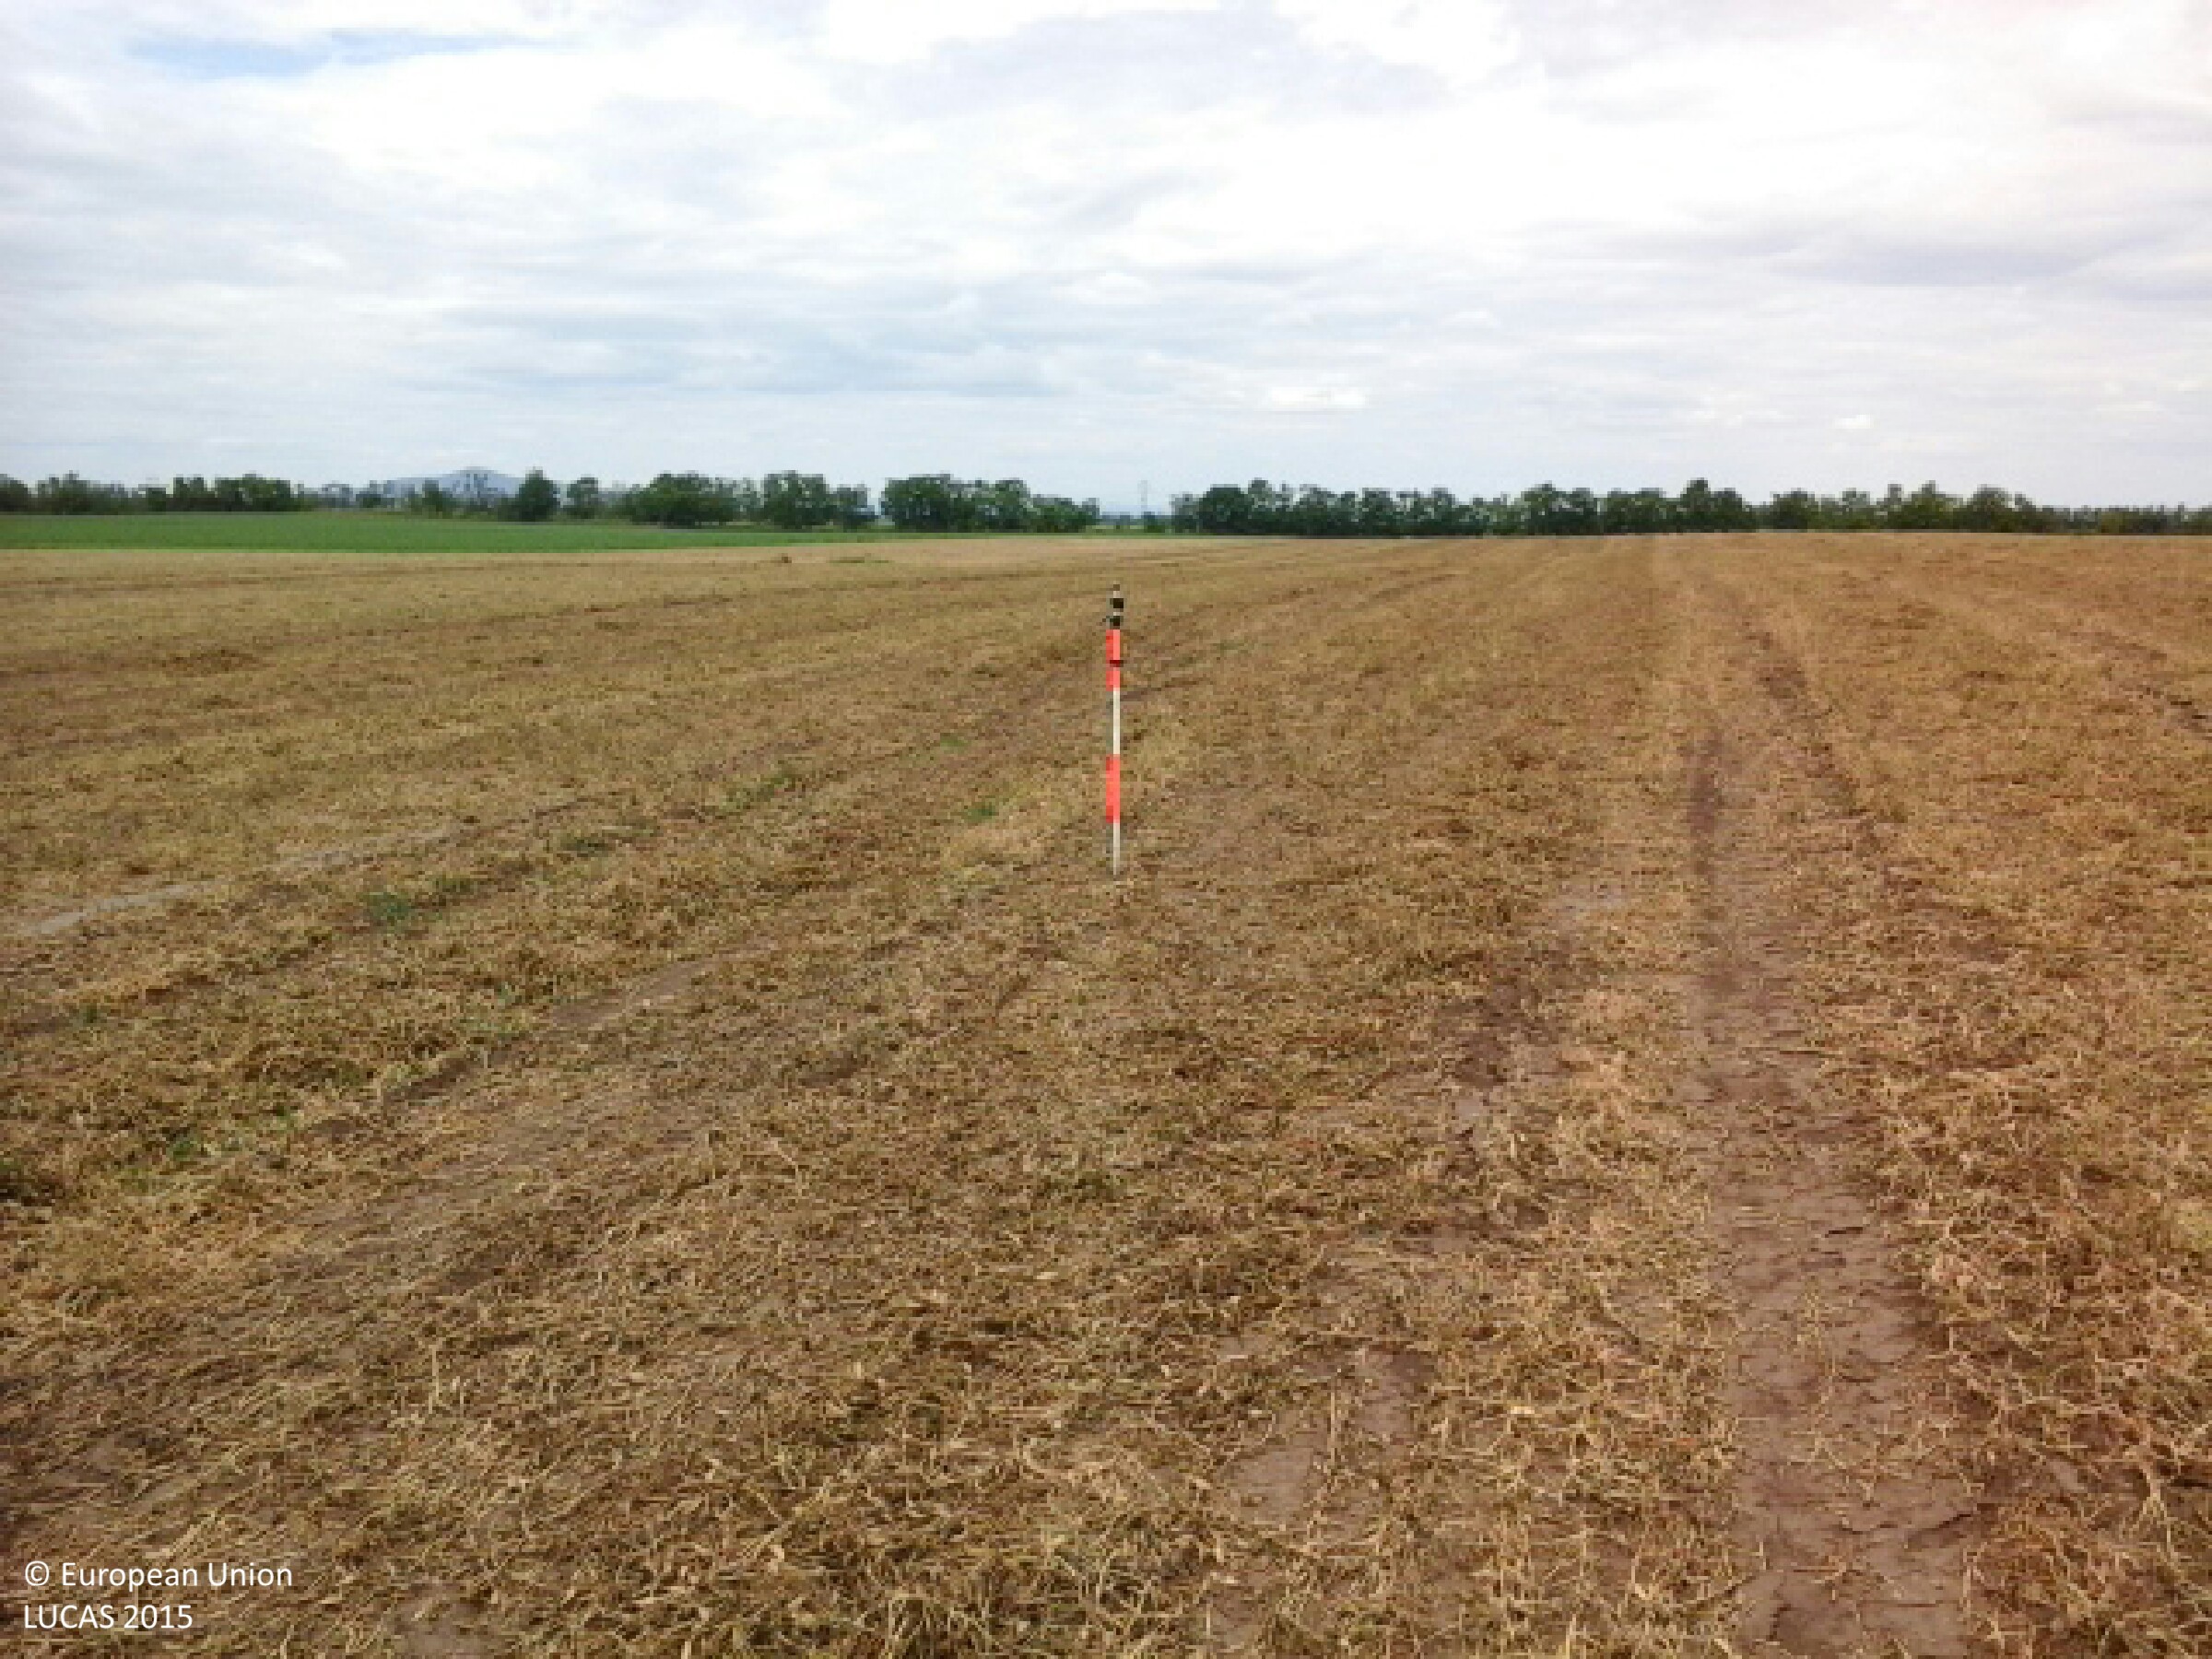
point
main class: Cropland
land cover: Dry pulses
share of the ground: < 10 %
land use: Agriculture (excluding fallow land and kitchen gardens)
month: June
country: HU
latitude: 47.9652
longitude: 21.4965
